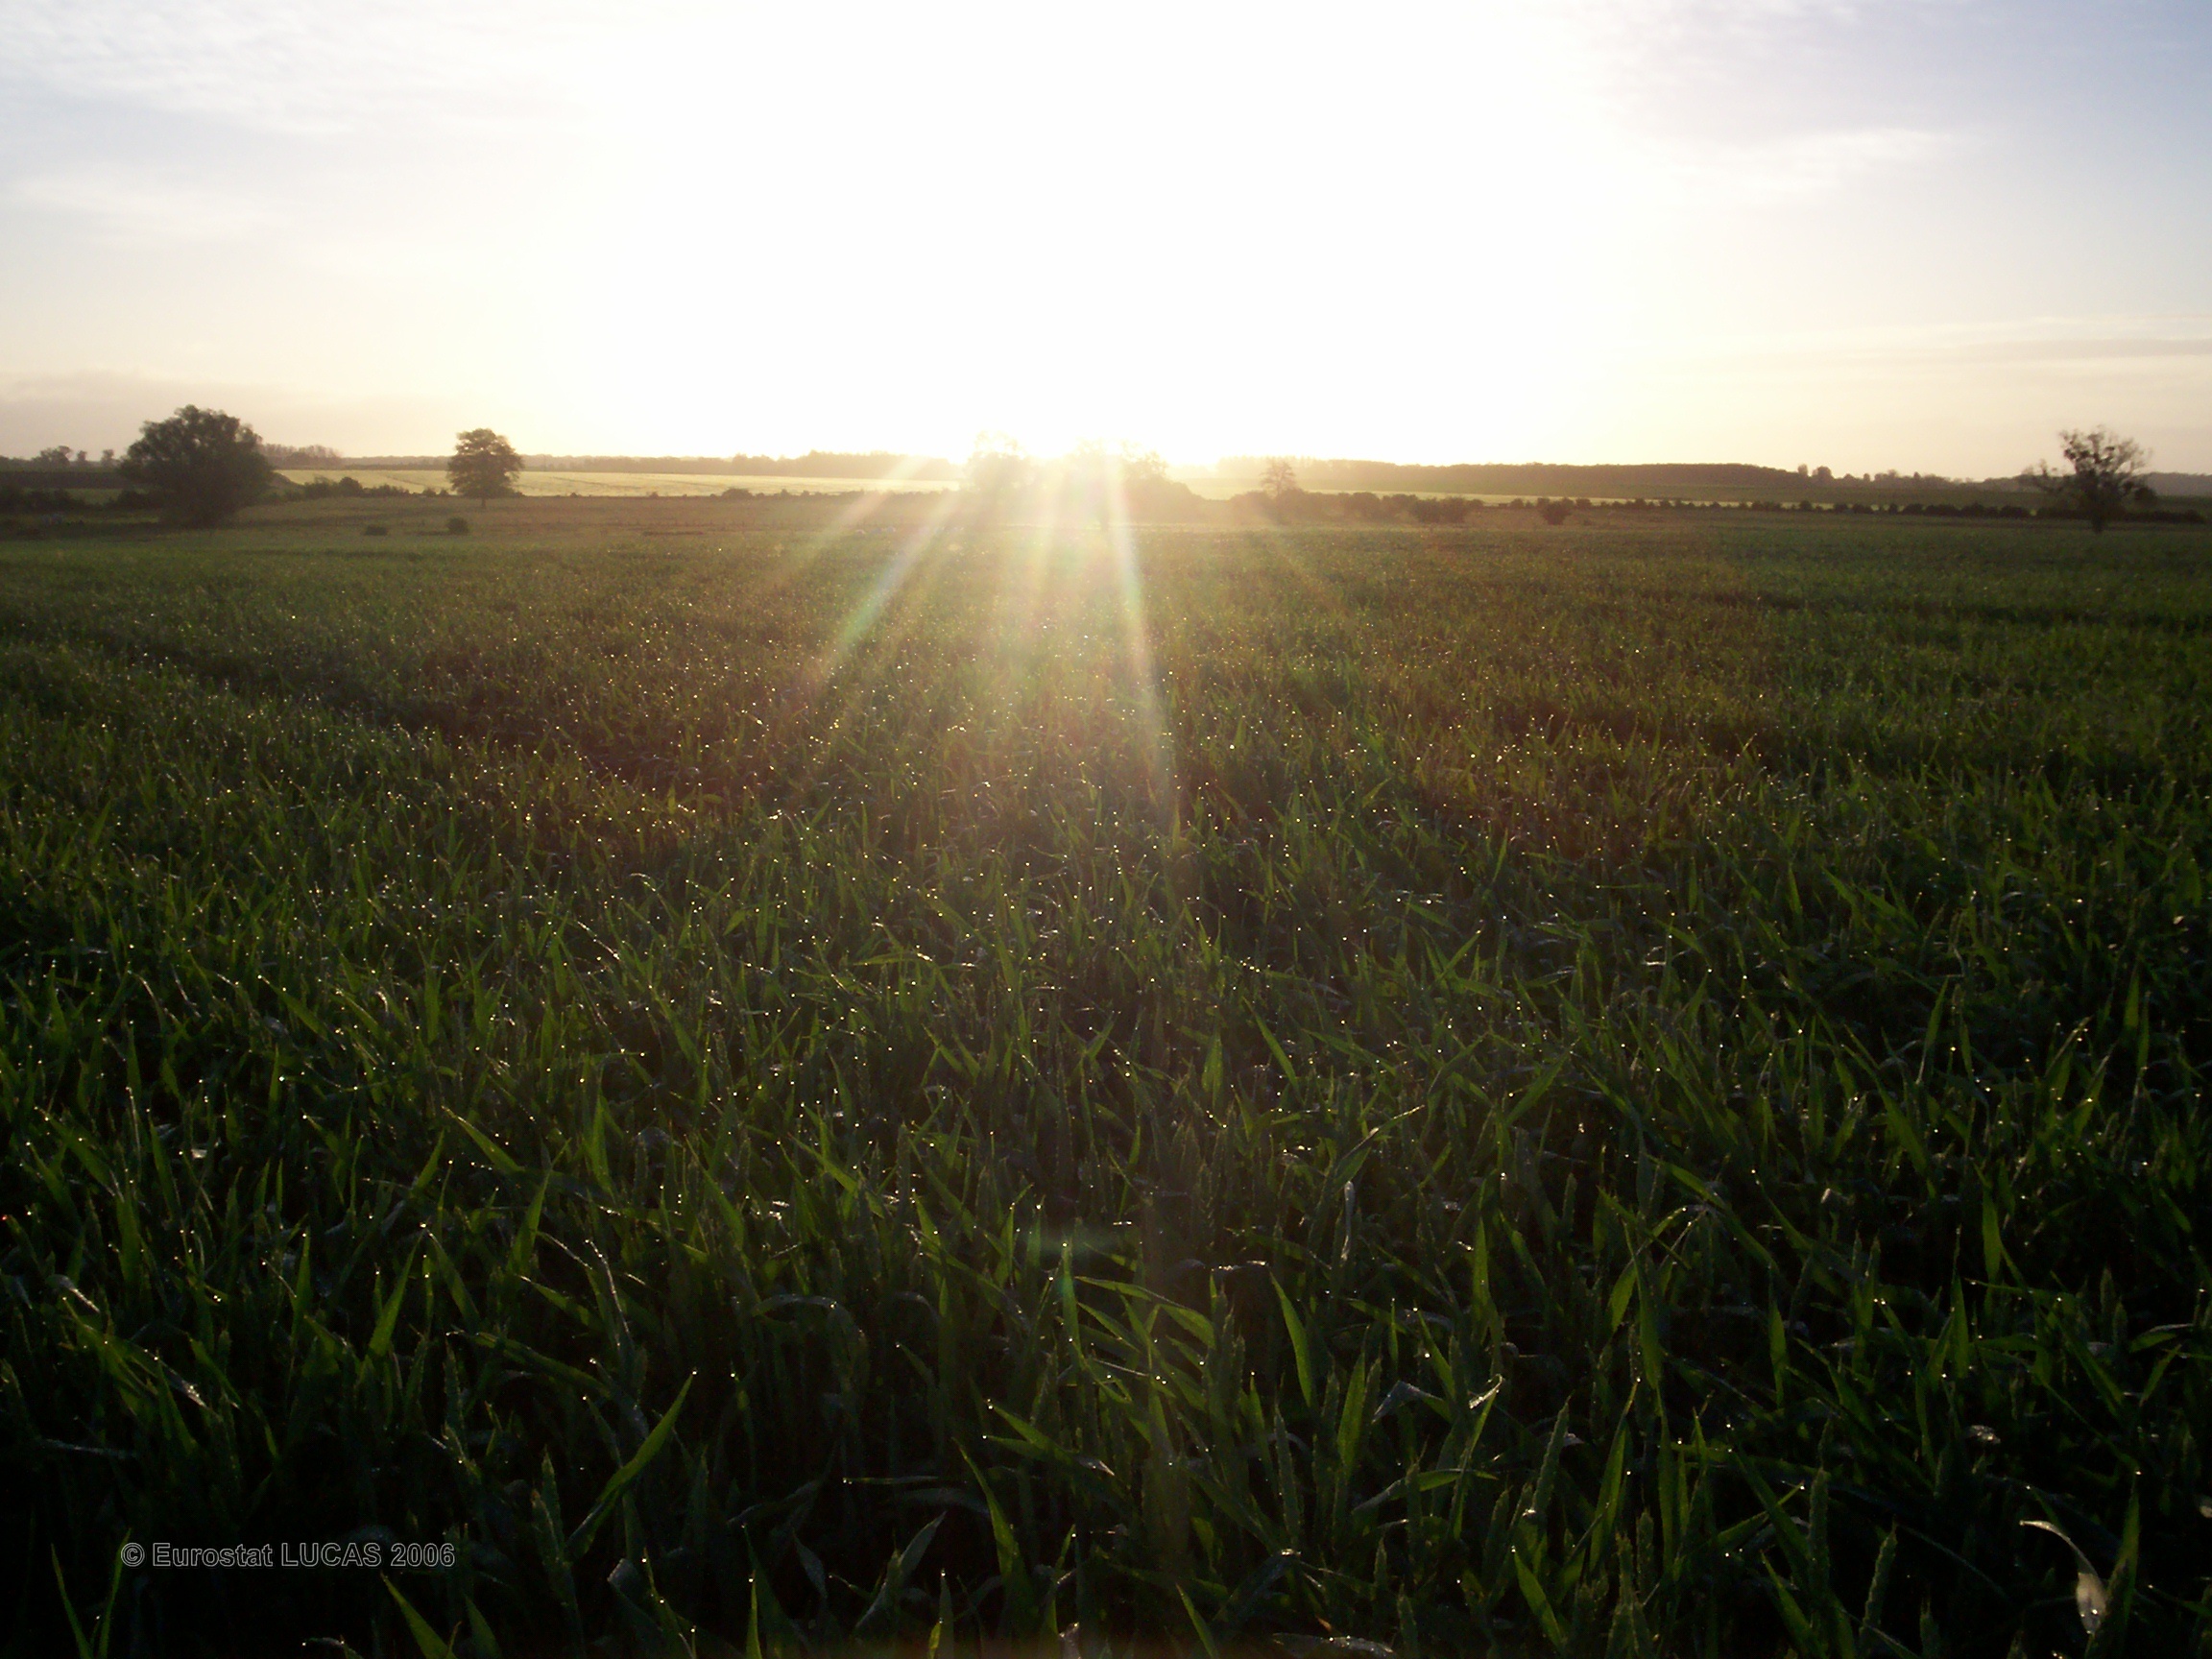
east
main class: Cropland
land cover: Common wheat
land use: Agriculture (excluding fallow land and kitchen gardens)
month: May
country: FR
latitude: 47.3314
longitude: 5.3296
